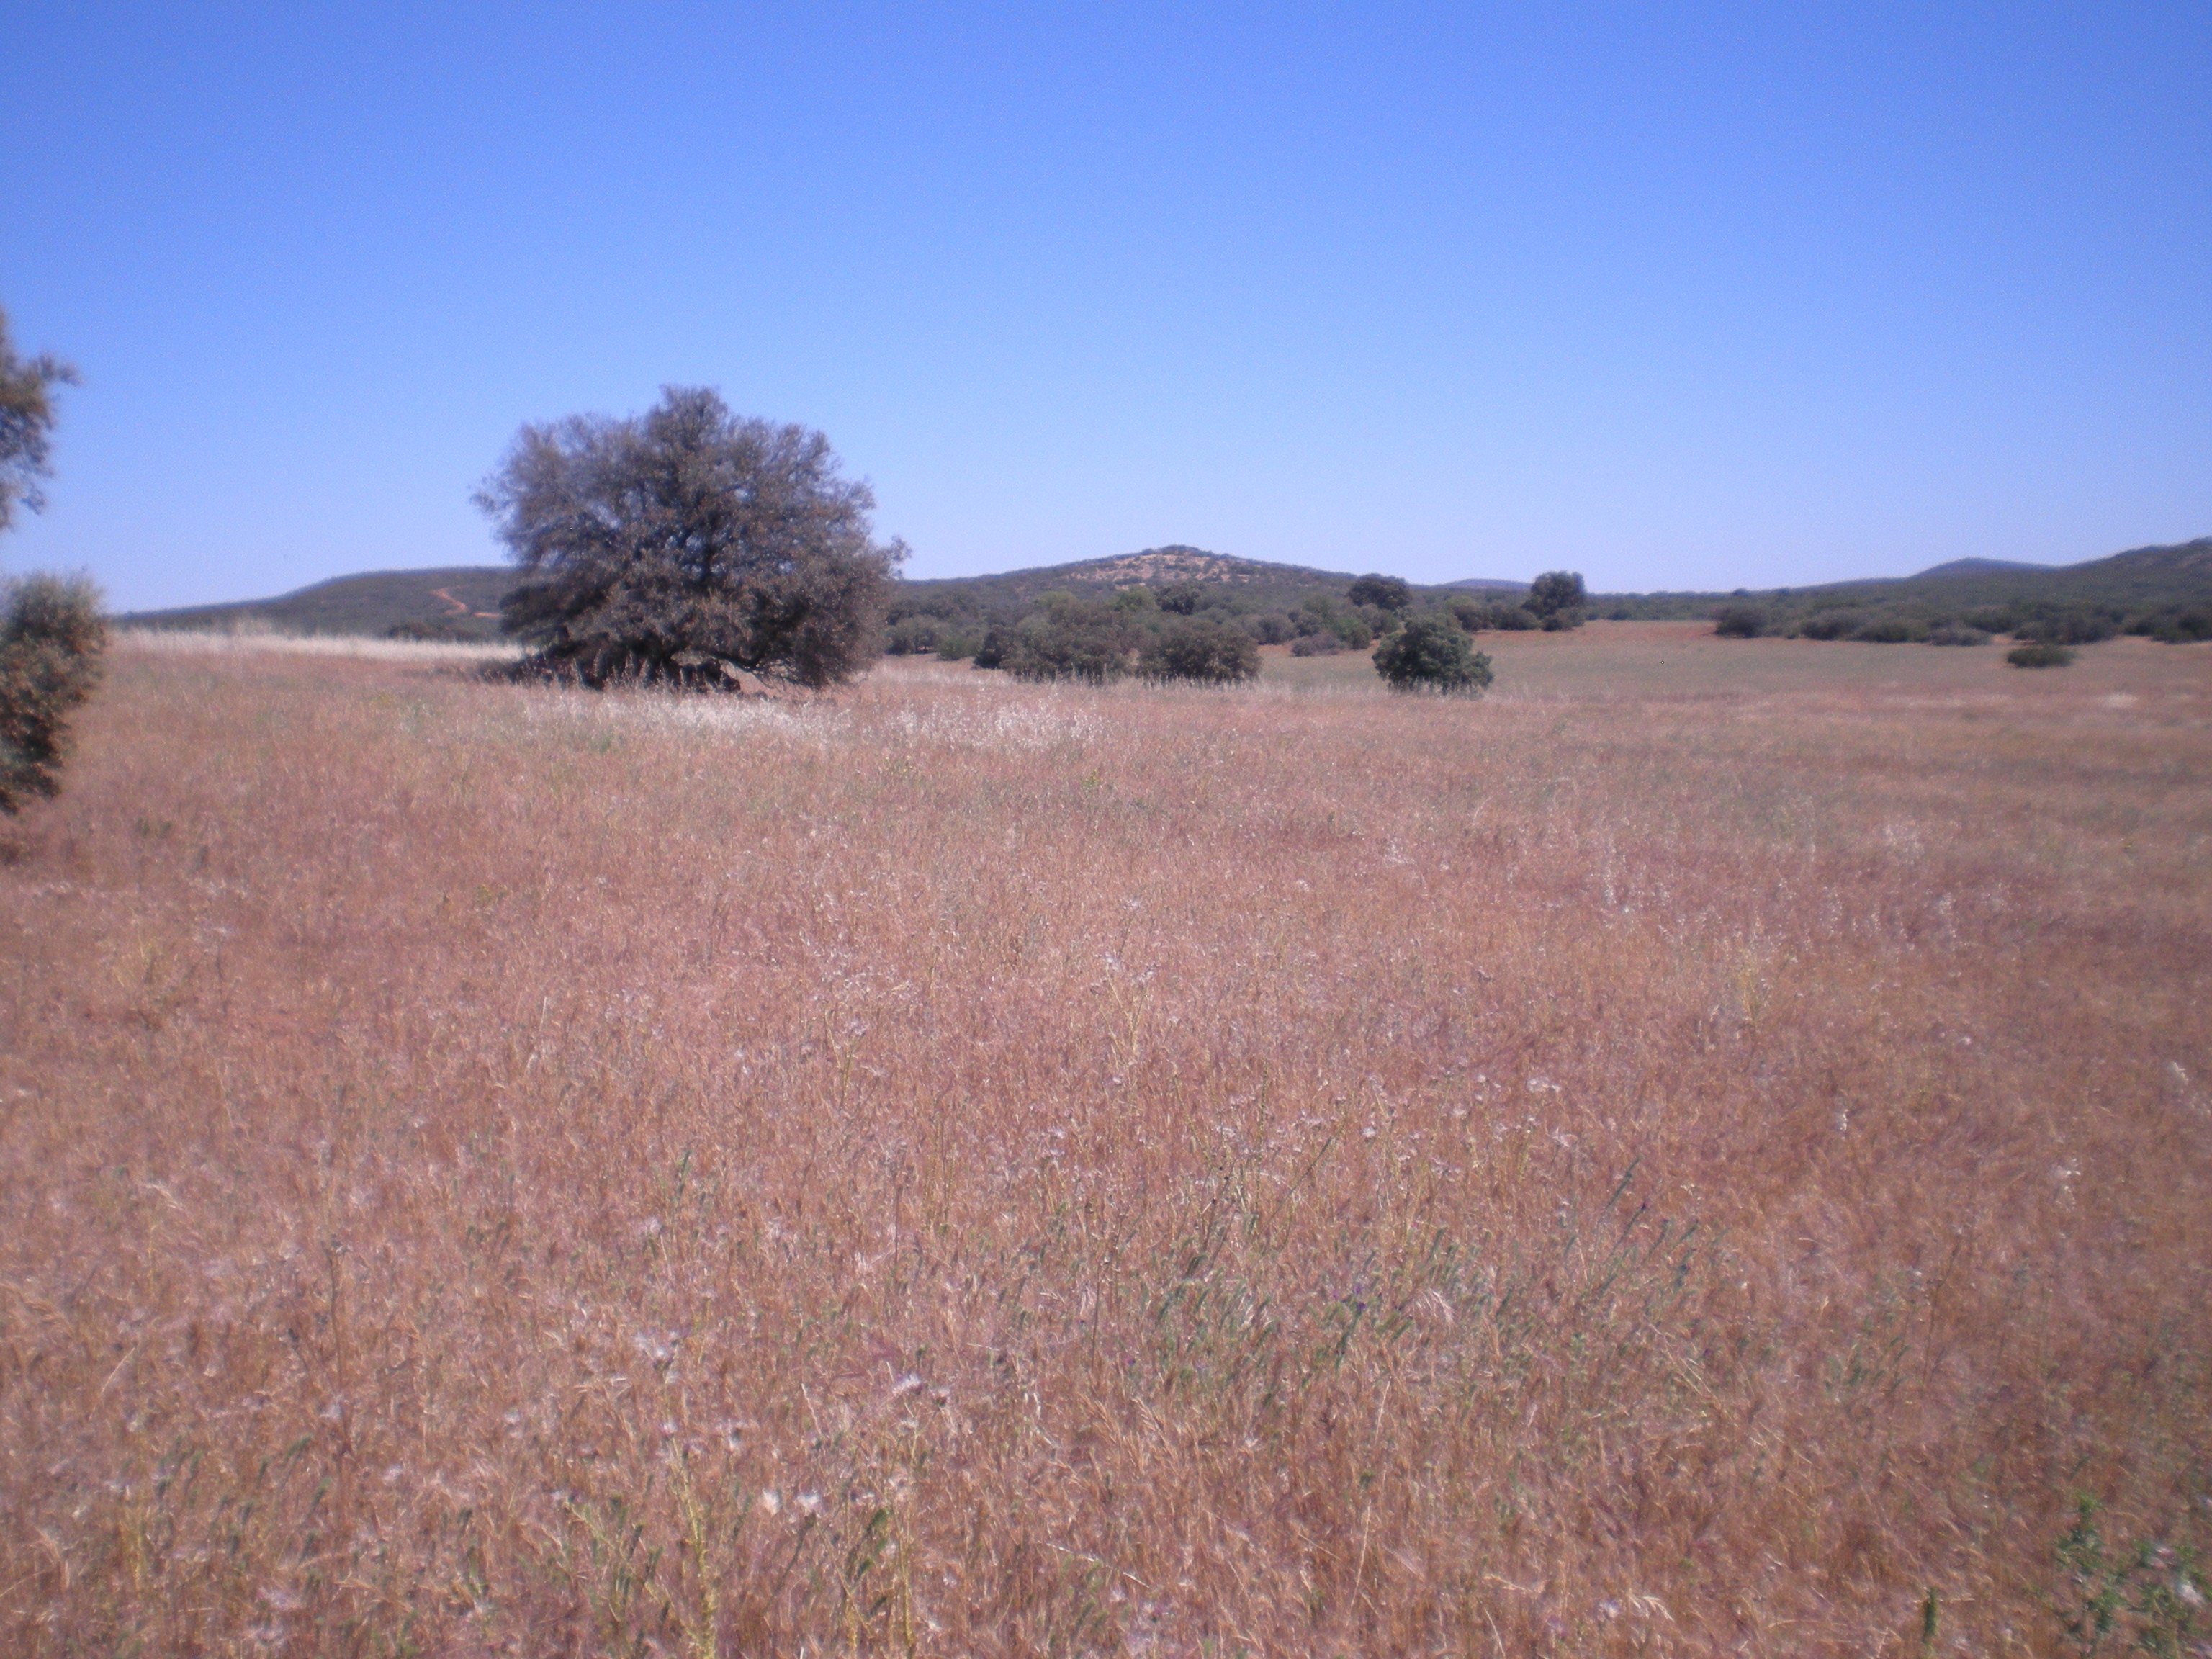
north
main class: Grassland
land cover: Grassland with sparse tree/shrub cover
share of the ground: > 75 %
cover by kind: unconsolidated bare surface 80 %, herbaceous plants 15 %, broadleaved forest trees 5 %
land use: Agriculture (excluding fallow land and kitchen gardens)
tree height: < 5 m
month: May
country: ES
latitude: 38.5136
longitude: -3.4377
